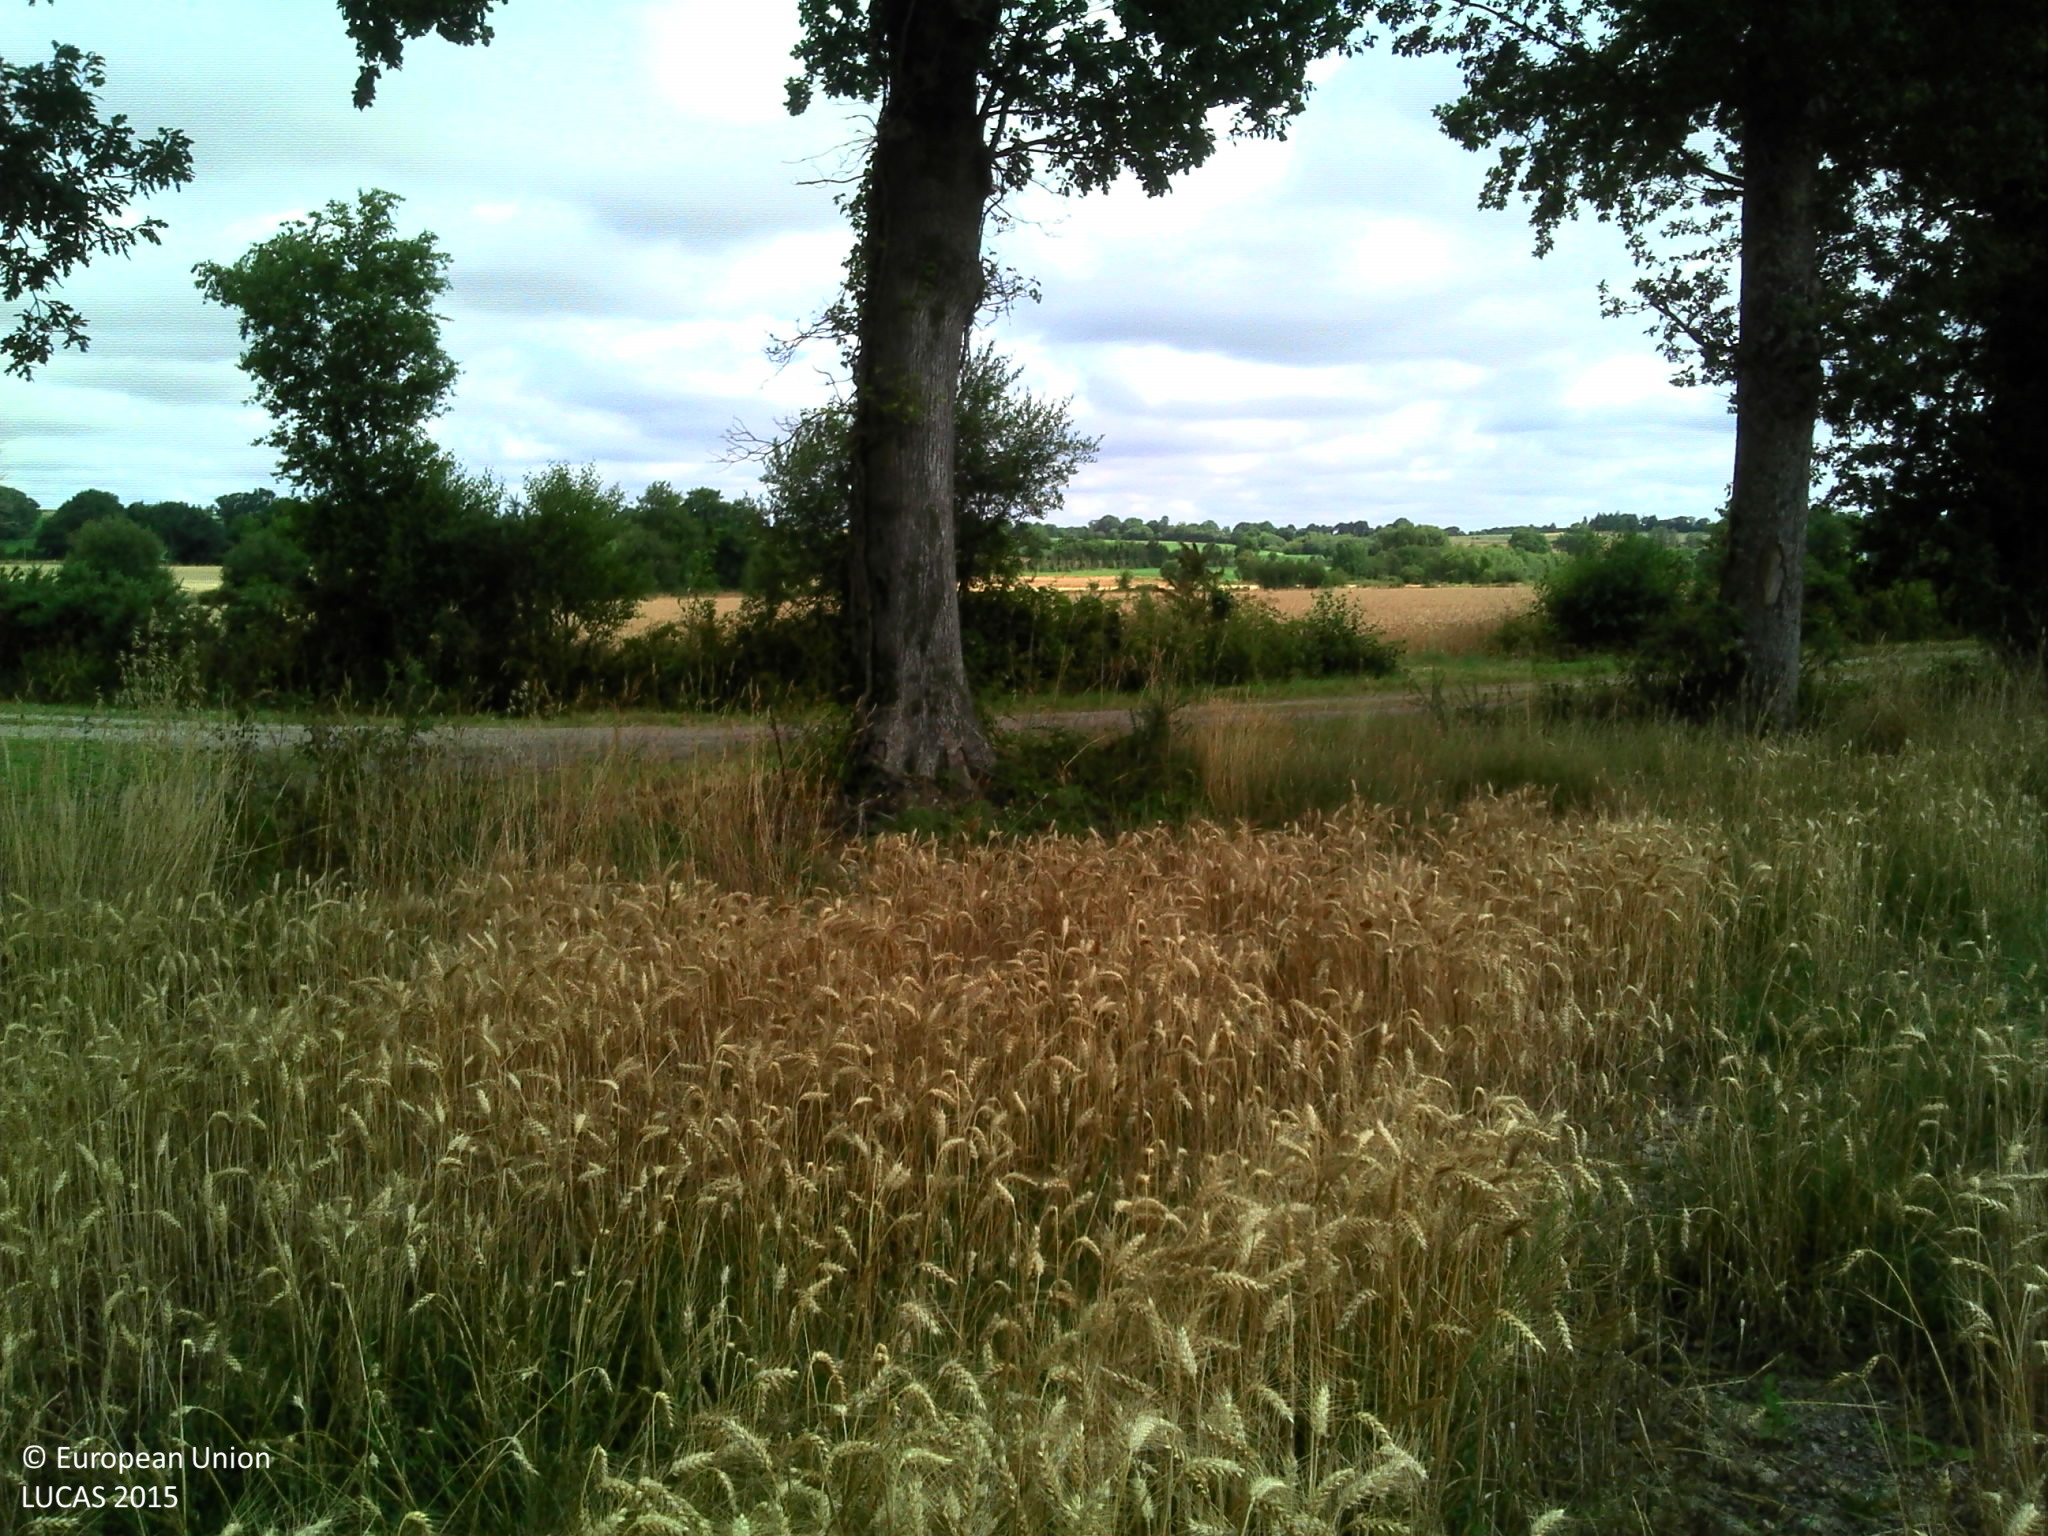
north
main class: Cropland
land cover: Common wheat
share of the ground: > 75 %
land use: Agriculture (excluding fallow land and kitchen gardens)
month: July
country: FR
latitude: 47.6096
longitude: -1.9286
